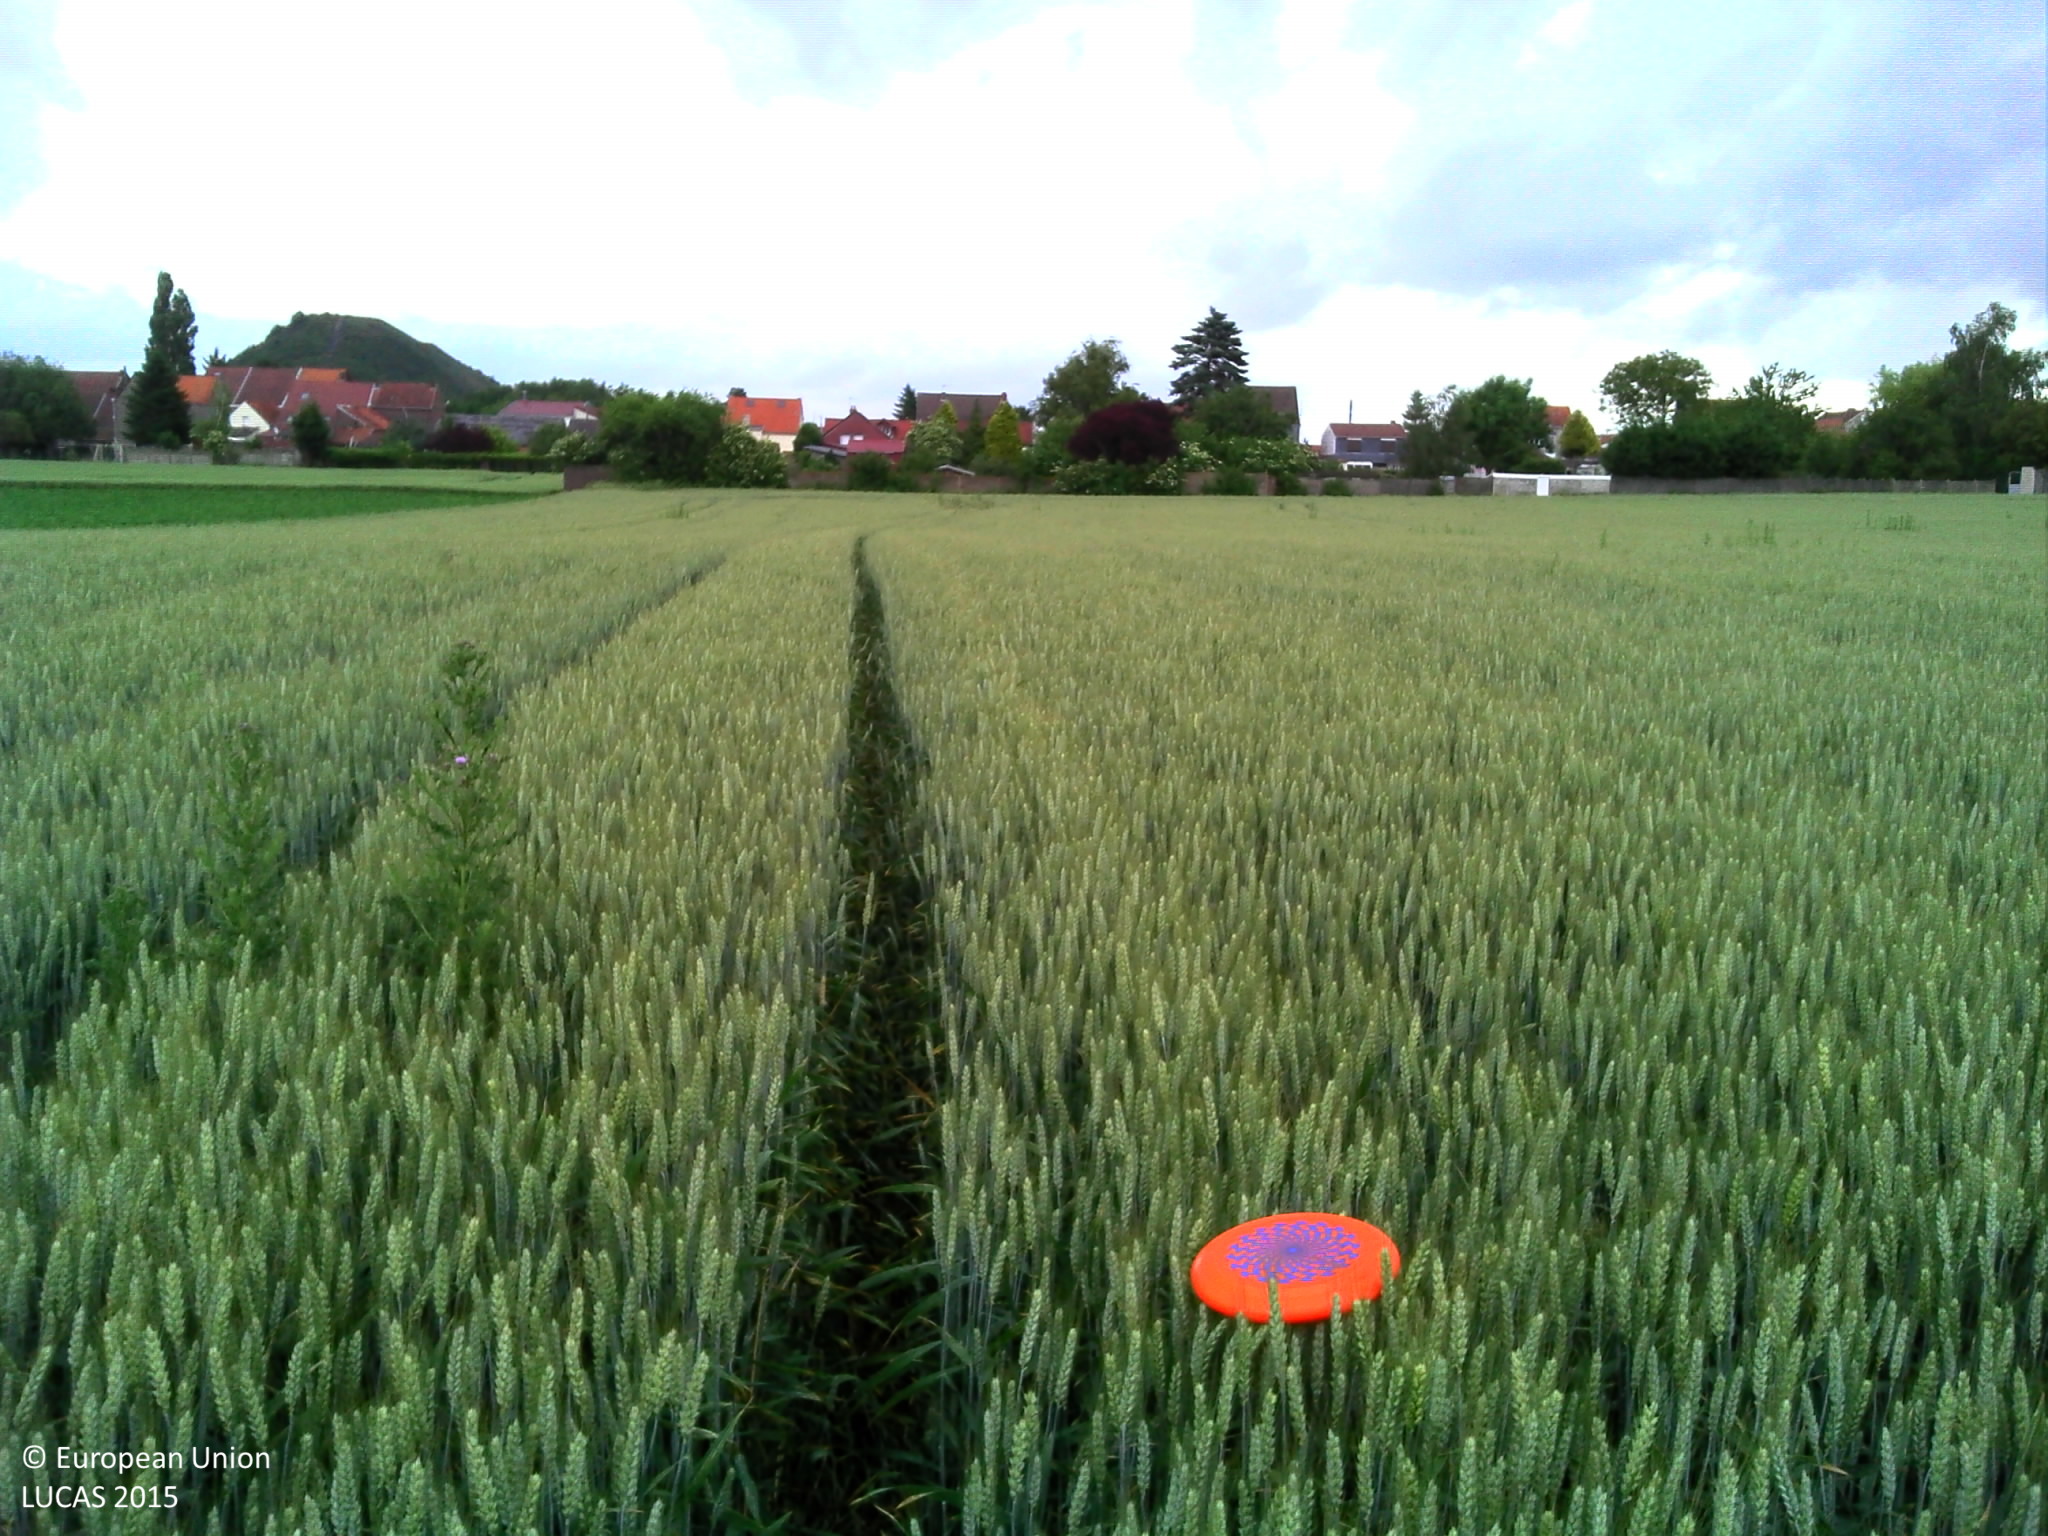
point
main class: Cropland
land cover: Common wheat
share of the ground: > 75 %
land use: Agriculture (excluding fallow land and kitchen gardens)
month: June
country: FR
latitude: 50.4952
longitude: 2.4736
